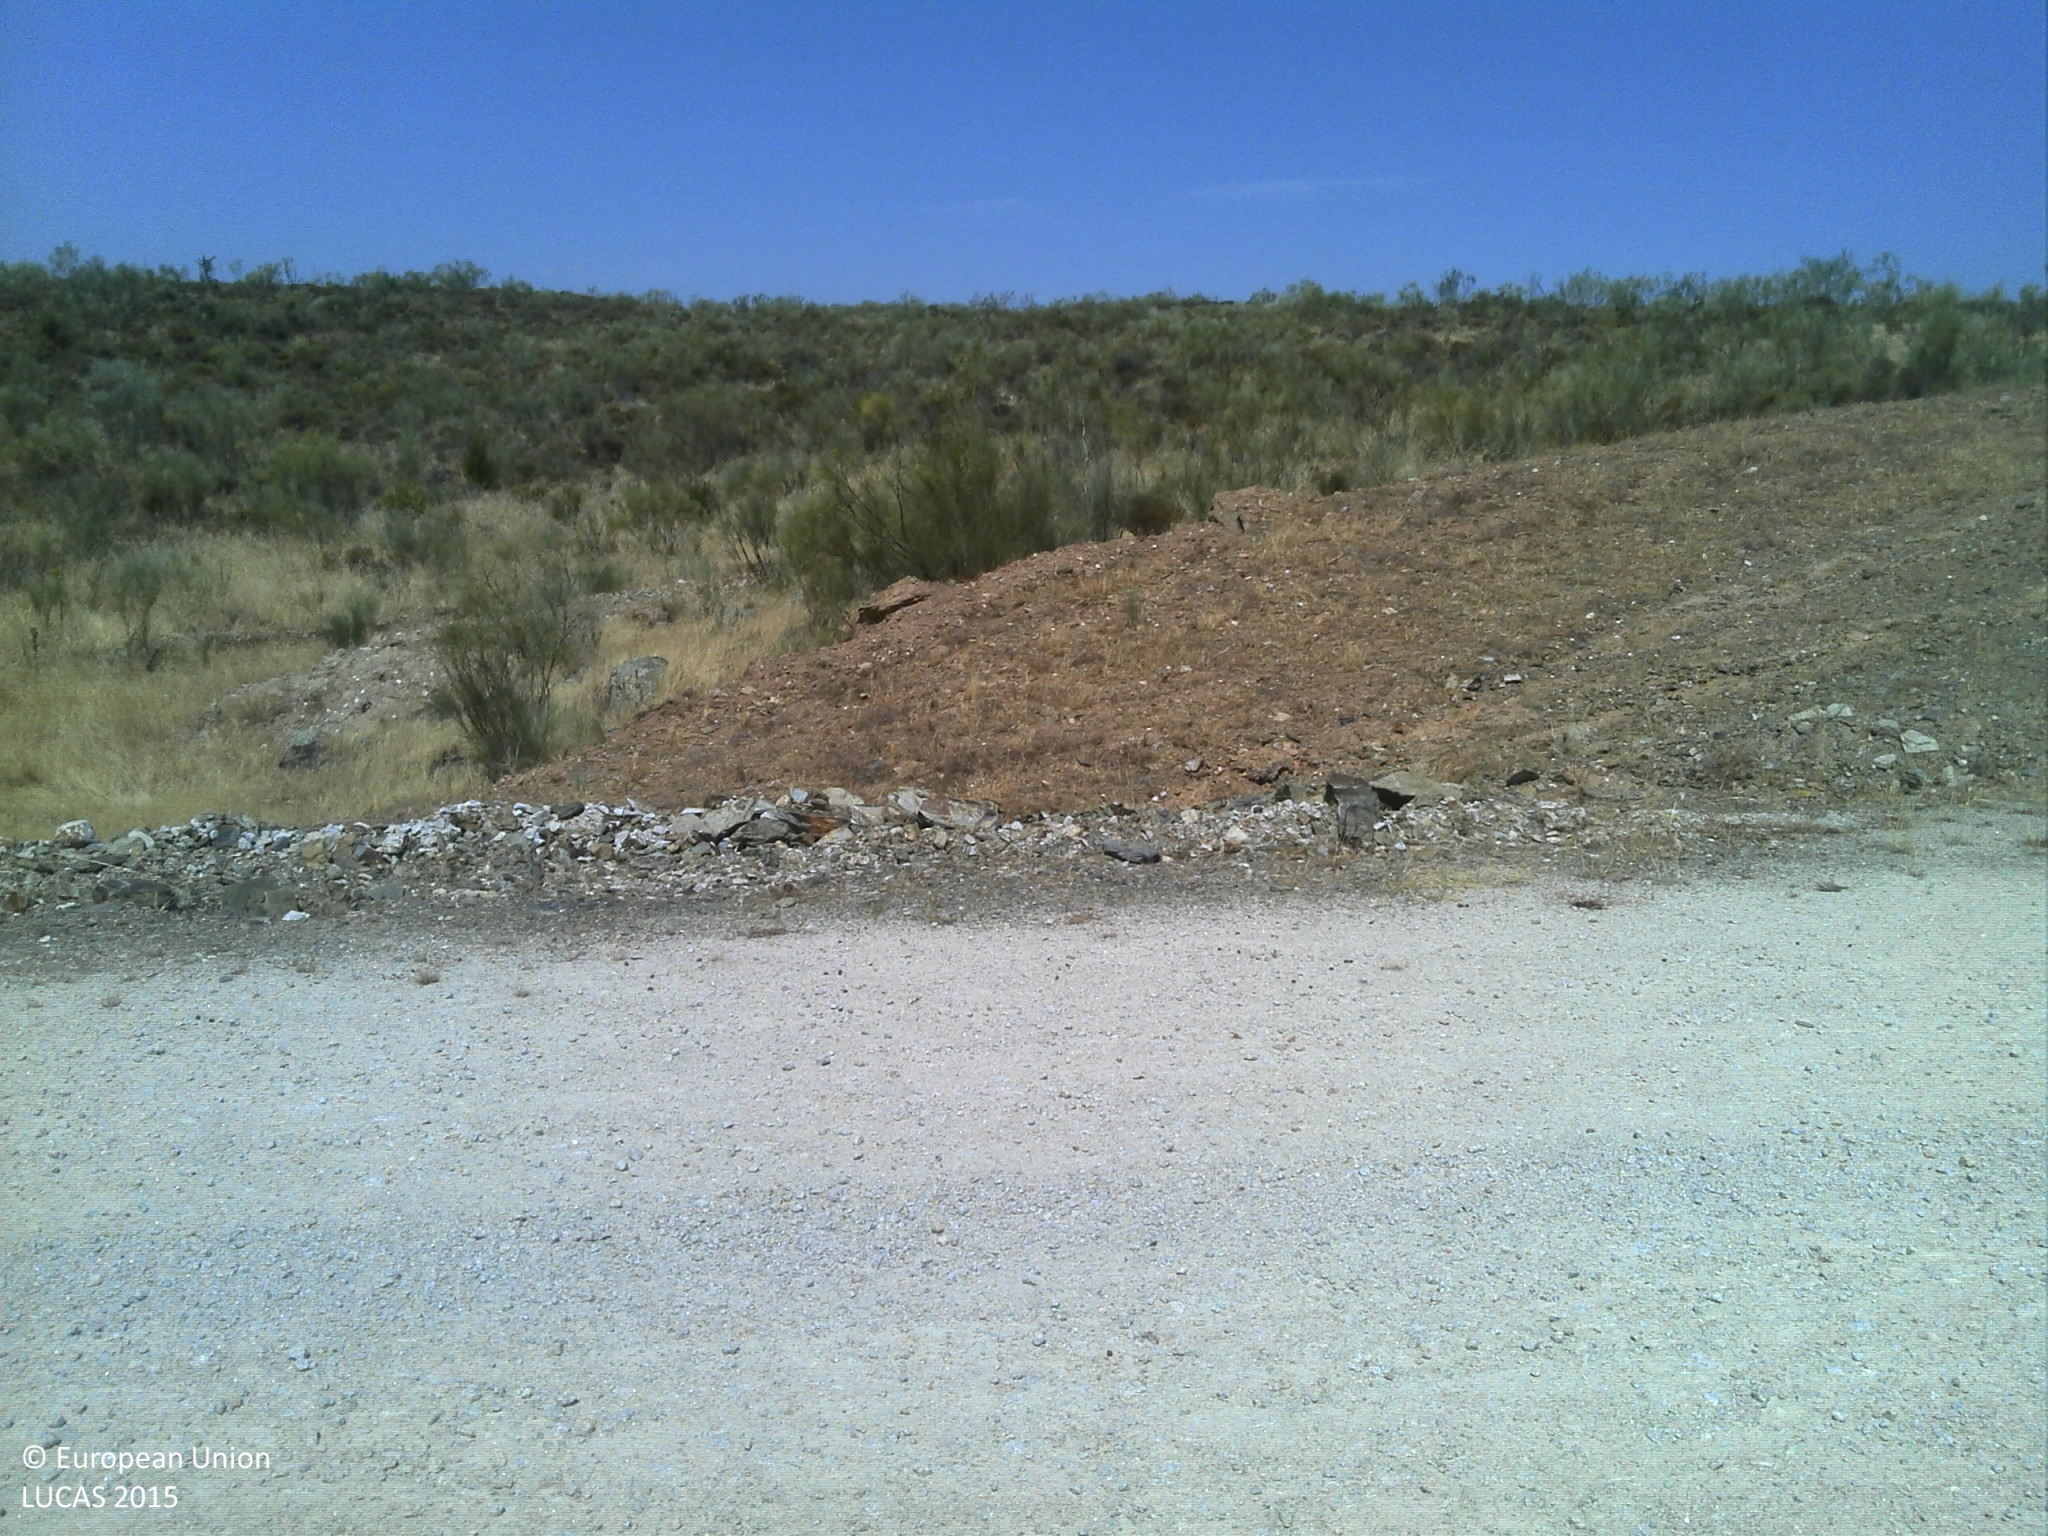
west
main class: Shrubland
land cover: Shrubland with sparse tree cover
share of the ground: 50 - 75 %
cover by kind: shrubs 65 %, herbaceous plants 30 %, broadleaved forest trees 5 %
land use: Abandoned areas
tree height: < 5 m
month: June
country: PT
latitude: 39.7236
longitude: -7.0378
